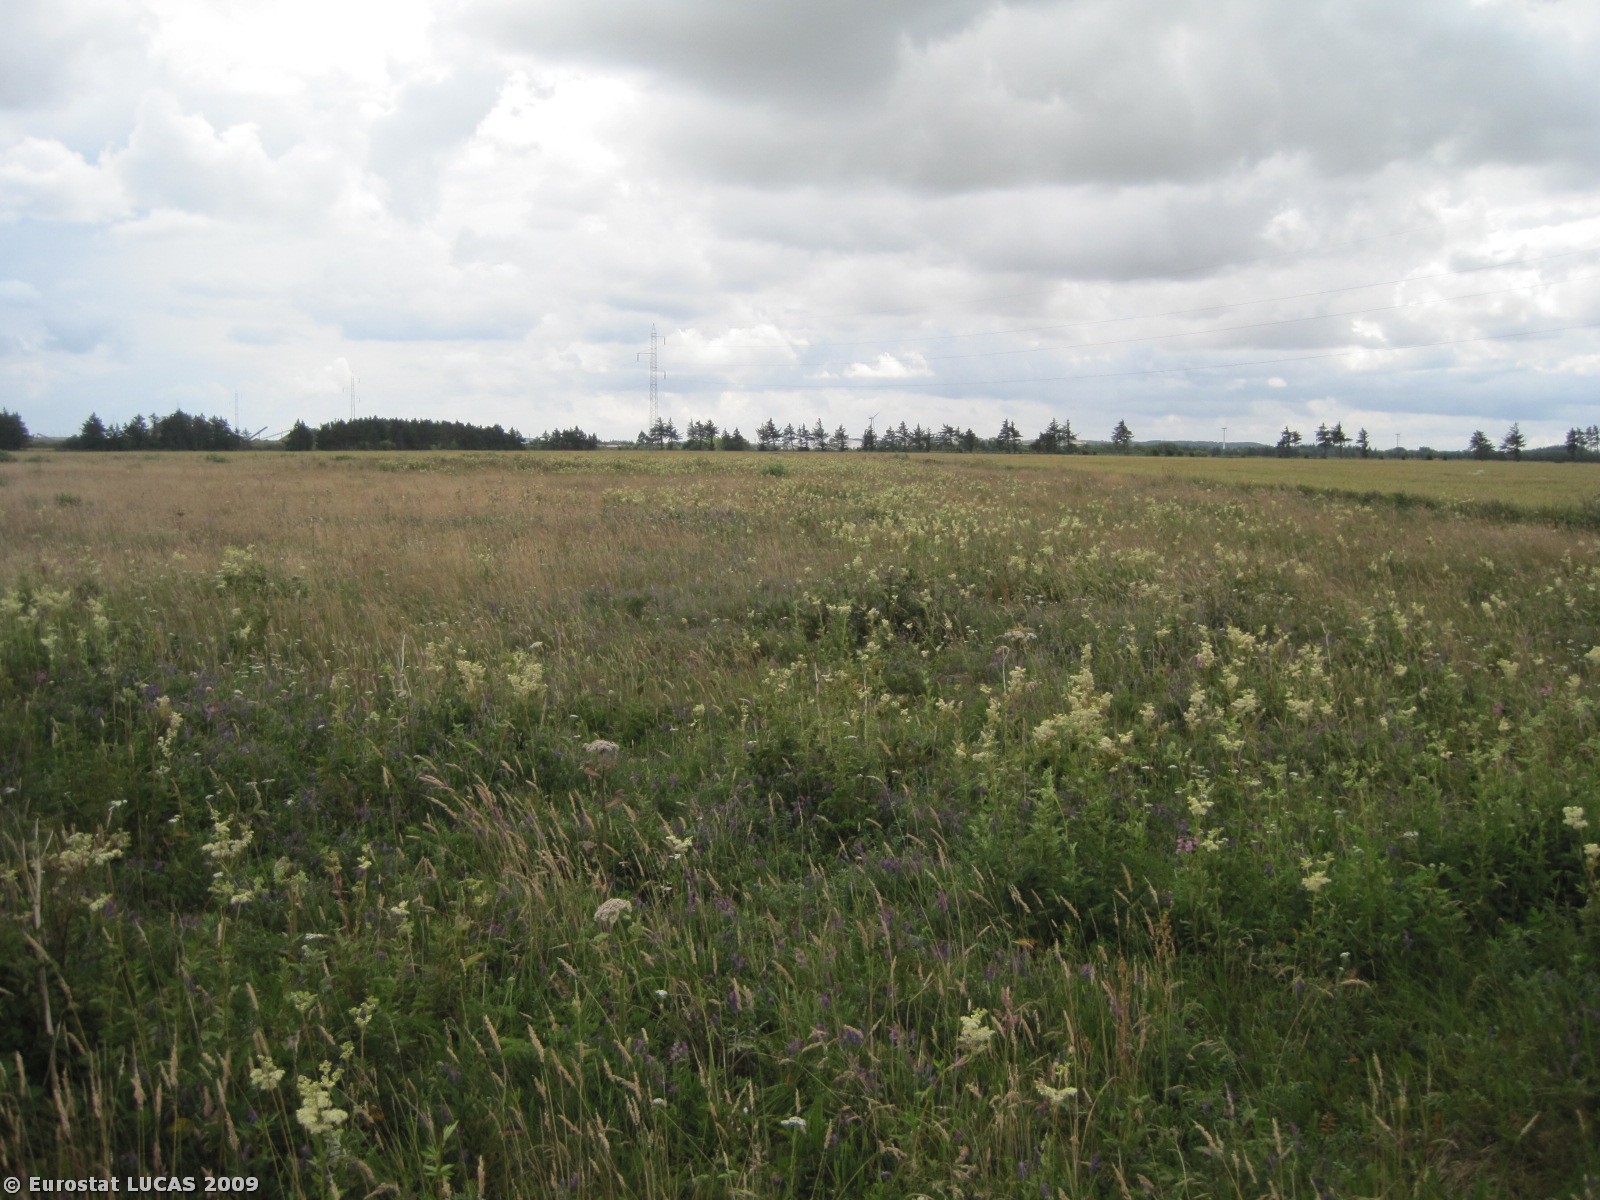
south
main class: Grassland
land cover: Grassland without tree/shrub cover
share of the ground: > 75 %
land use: Unused
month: July
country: DK
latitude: 57.0628
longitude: 8.7651
